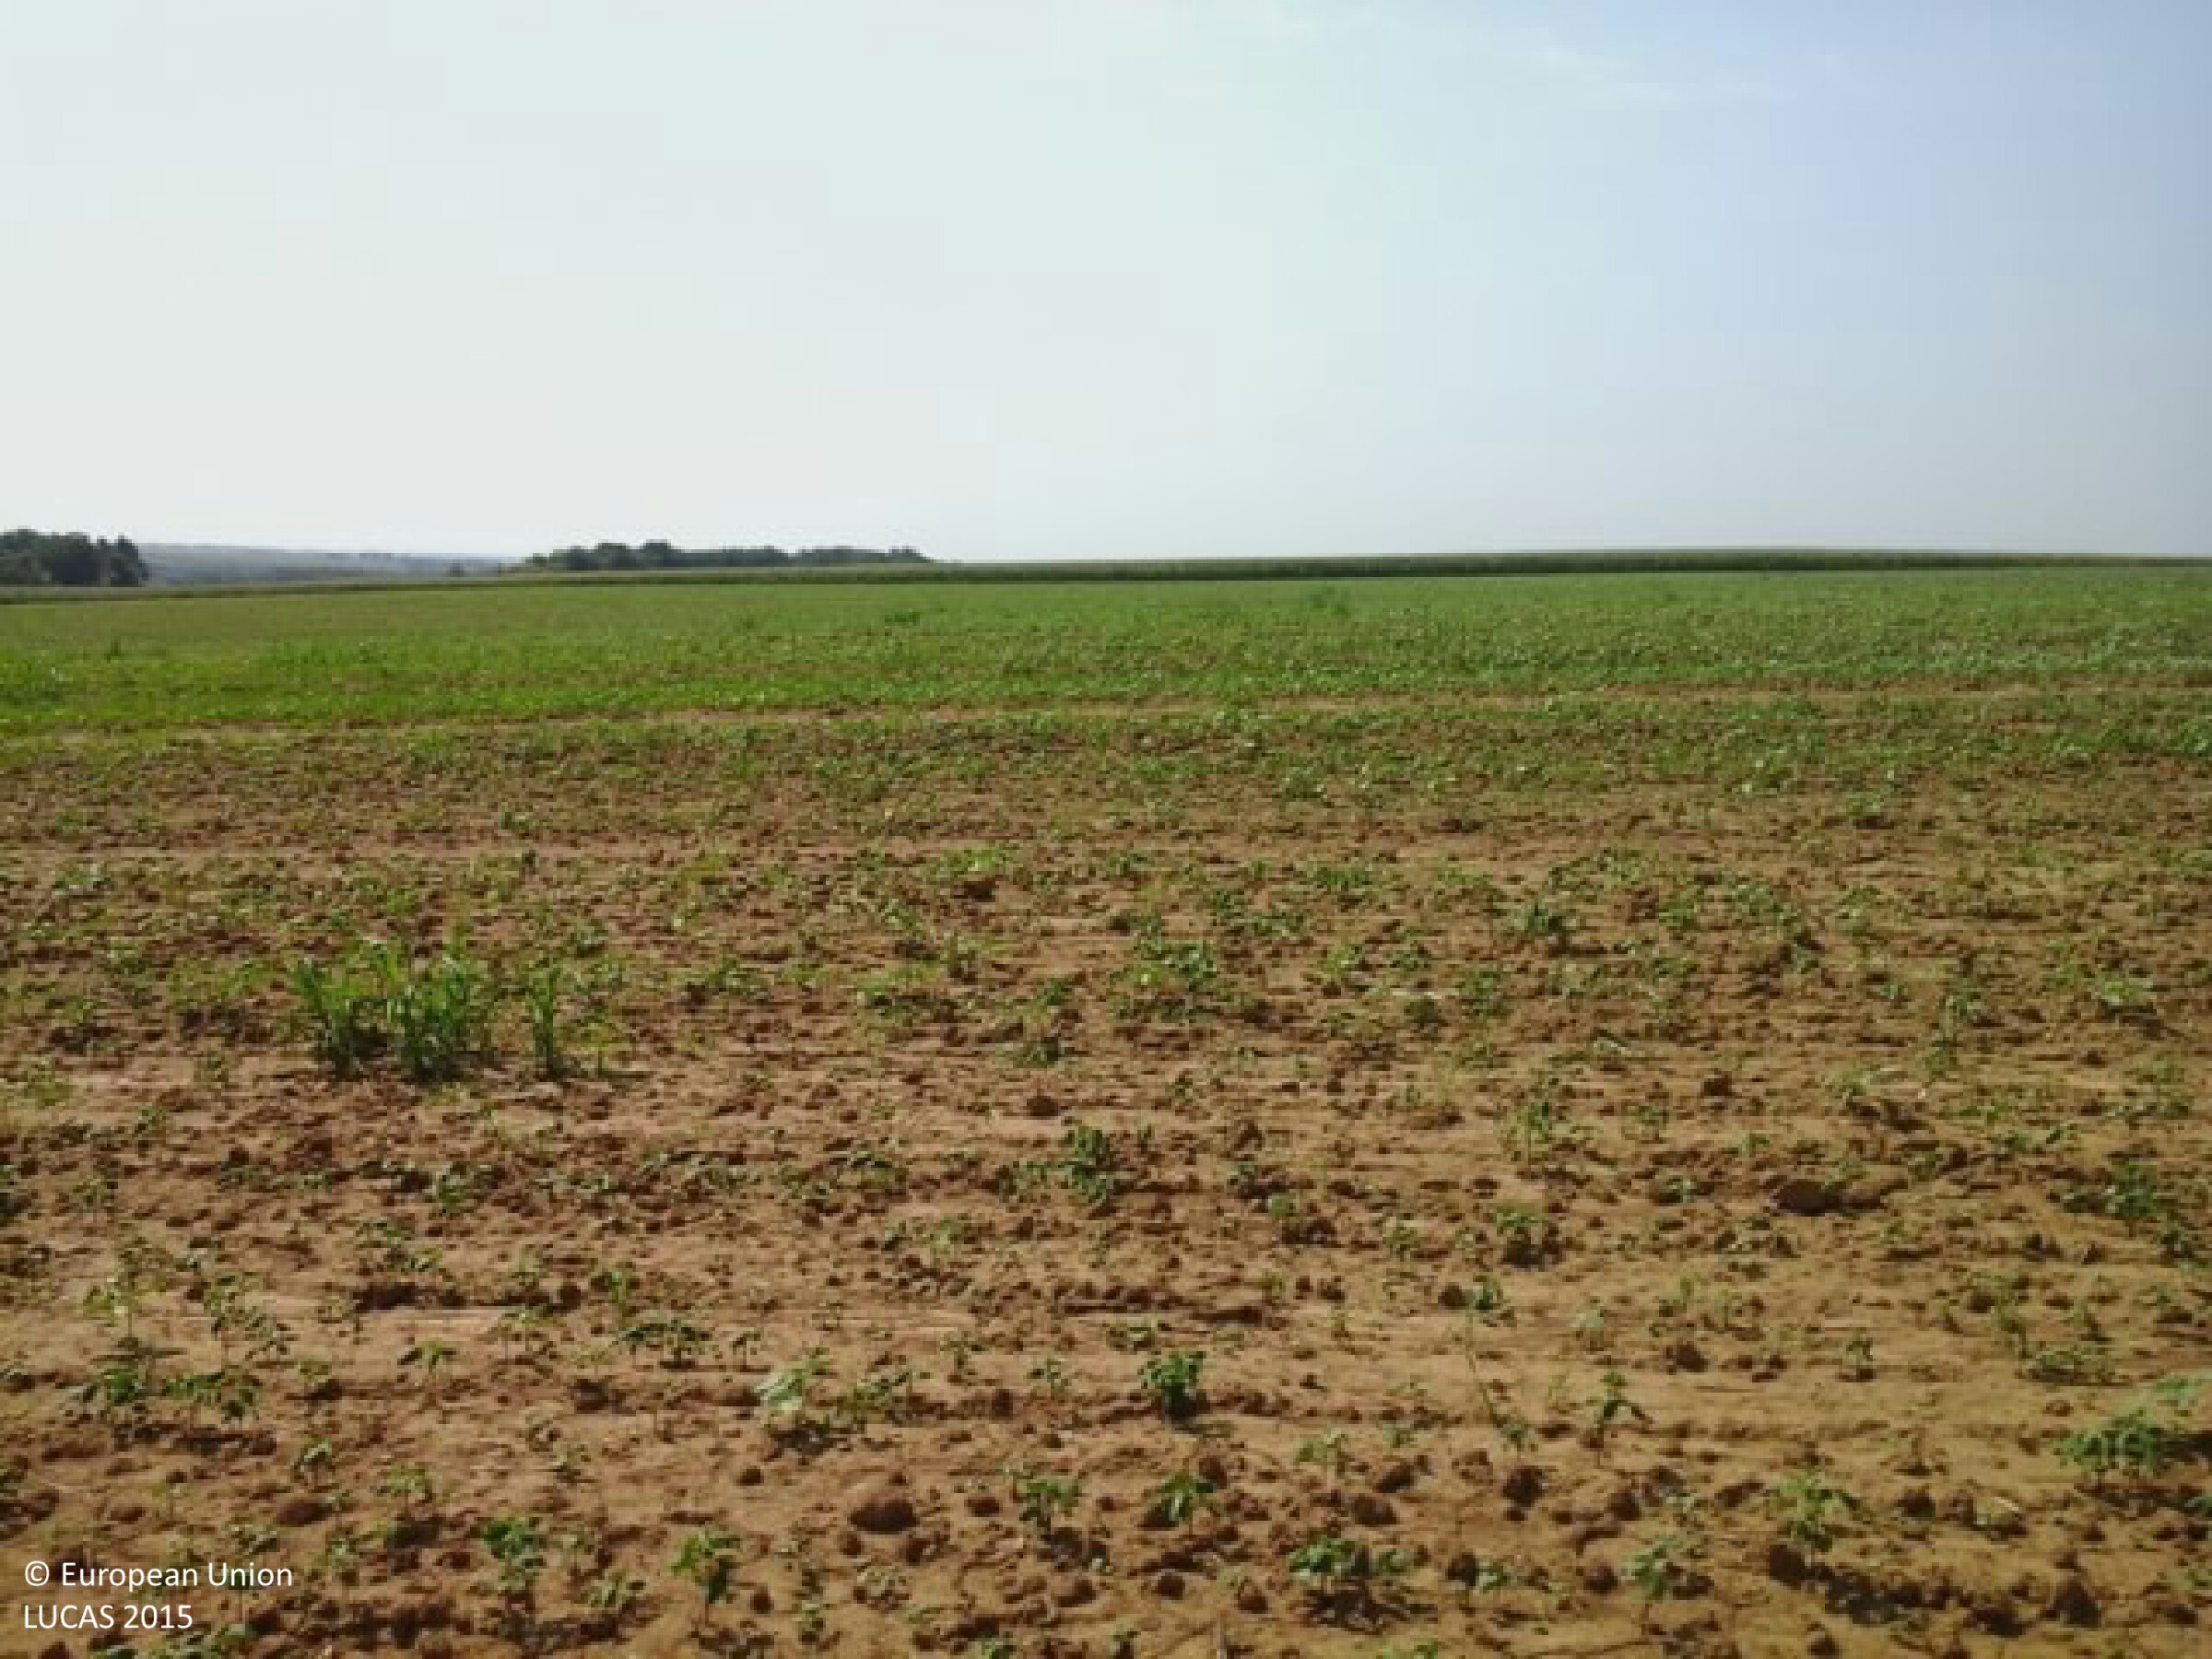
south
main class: Cropland
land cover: Other cereals
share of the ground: 50 - 75 %
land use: Agriculture (excluding fallow land and kitchen gardens)
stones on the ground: < 10 %
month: August
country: HU
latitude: 46.5314
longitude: 17.8686
